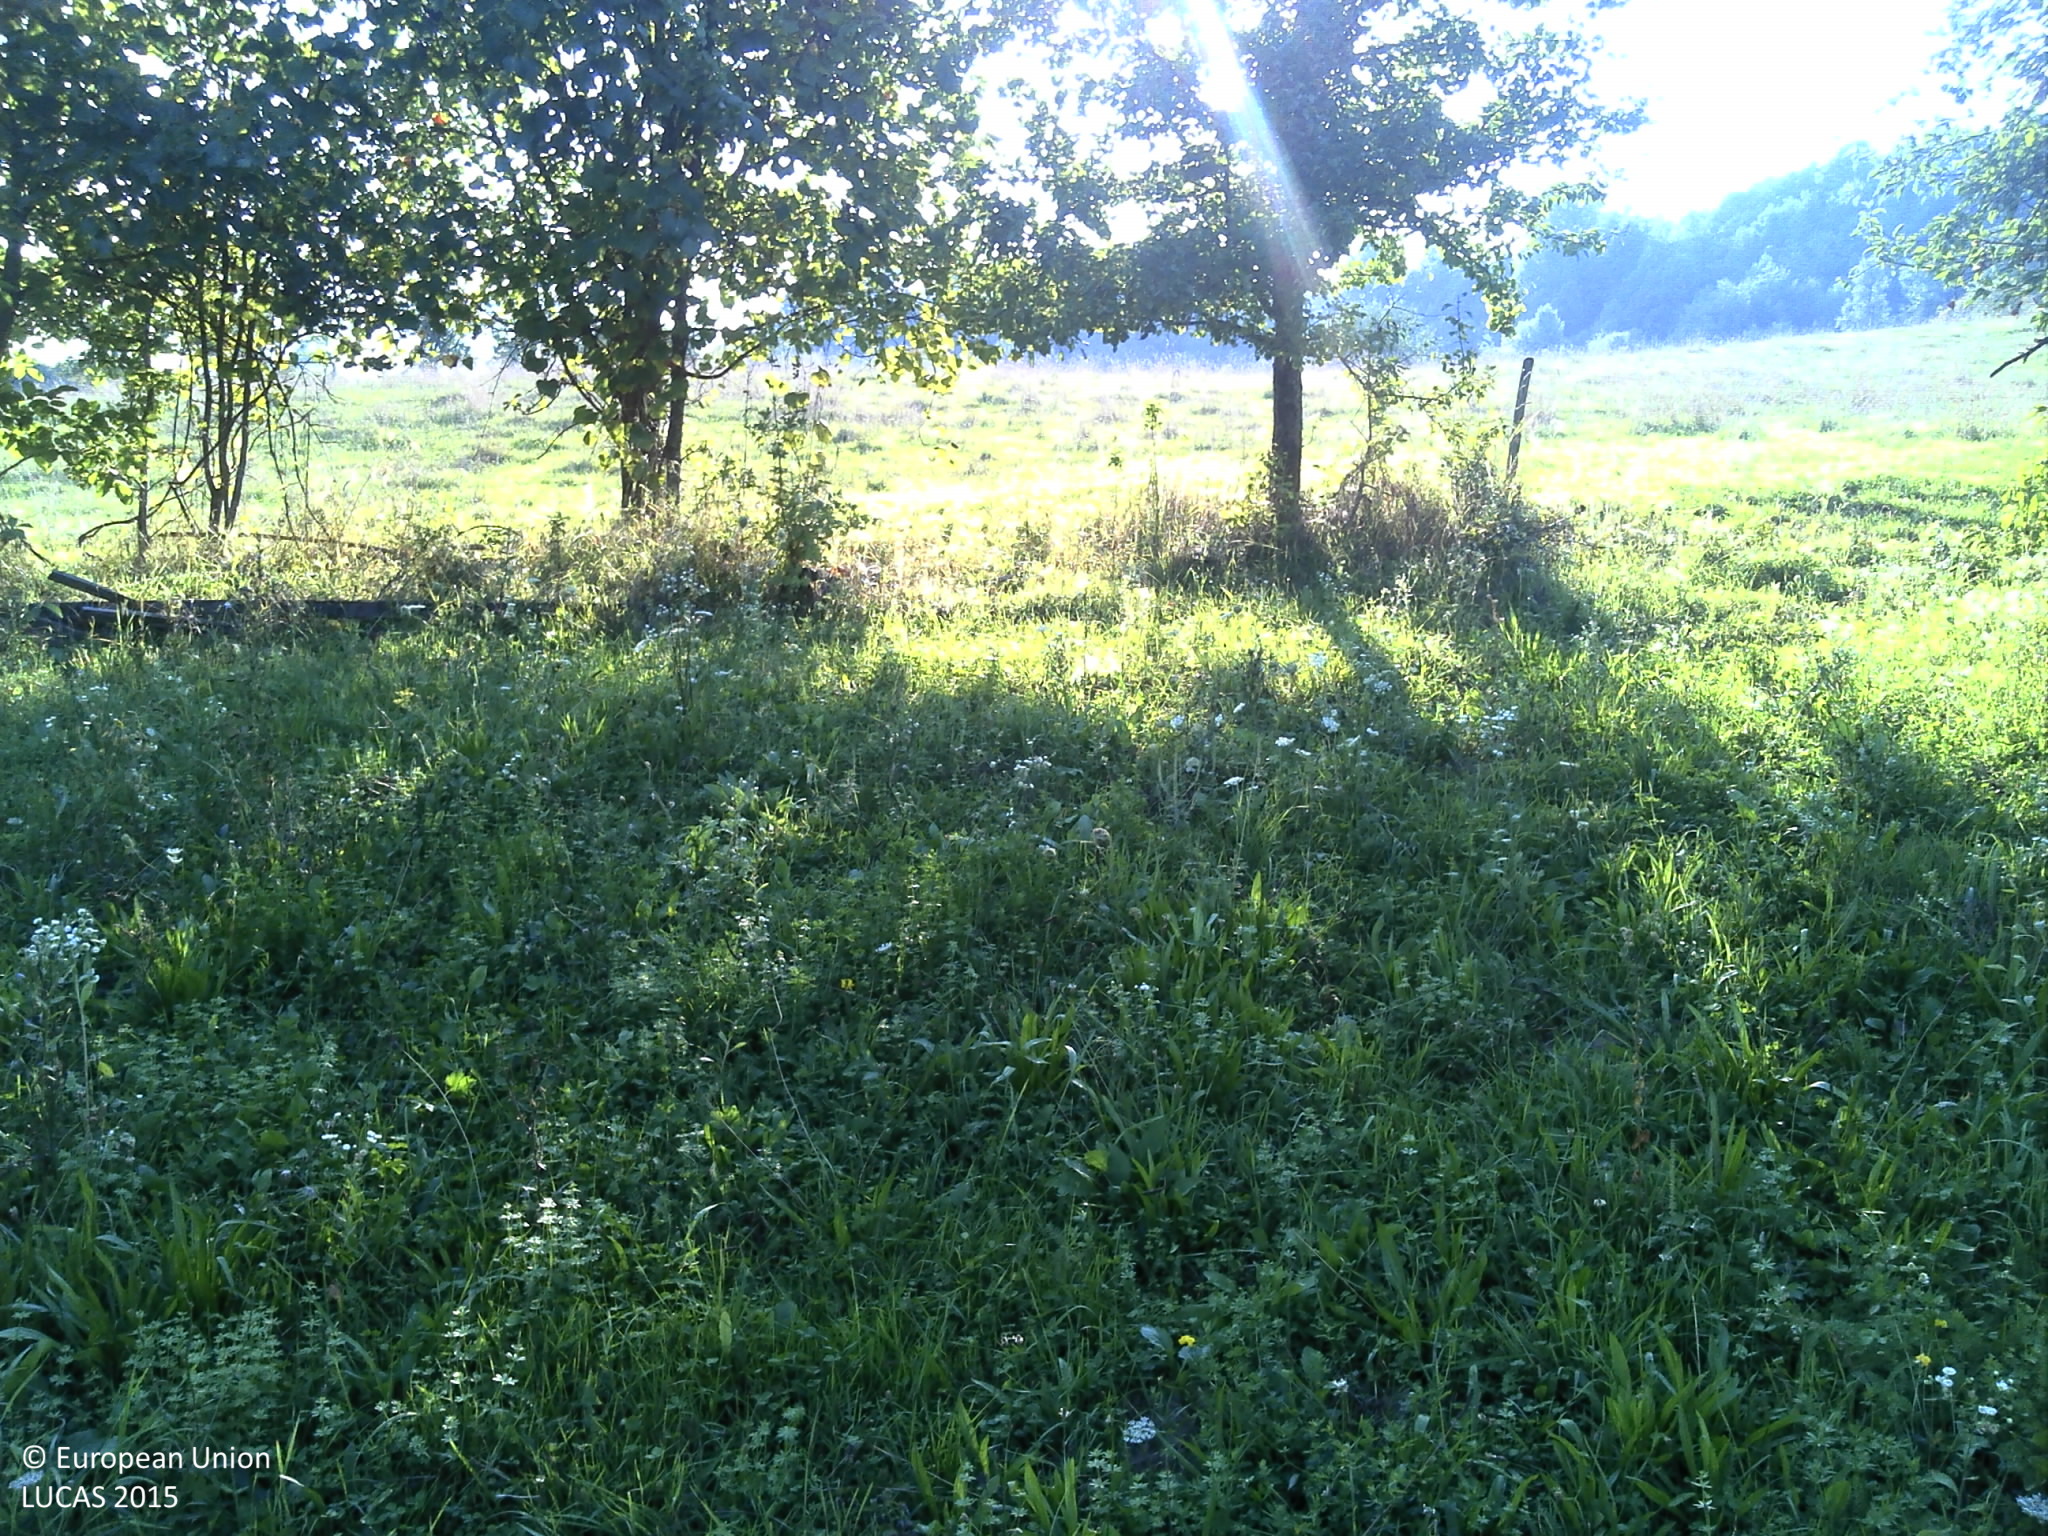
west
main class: Grassland
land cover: Spontaneously vegetated surfaces
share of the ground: > 75 %
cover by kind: herbaceous plants 100 %
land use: Semi-natural and natural areas not in use
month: August
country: HR
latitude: 45.1360
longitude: 16.2909
